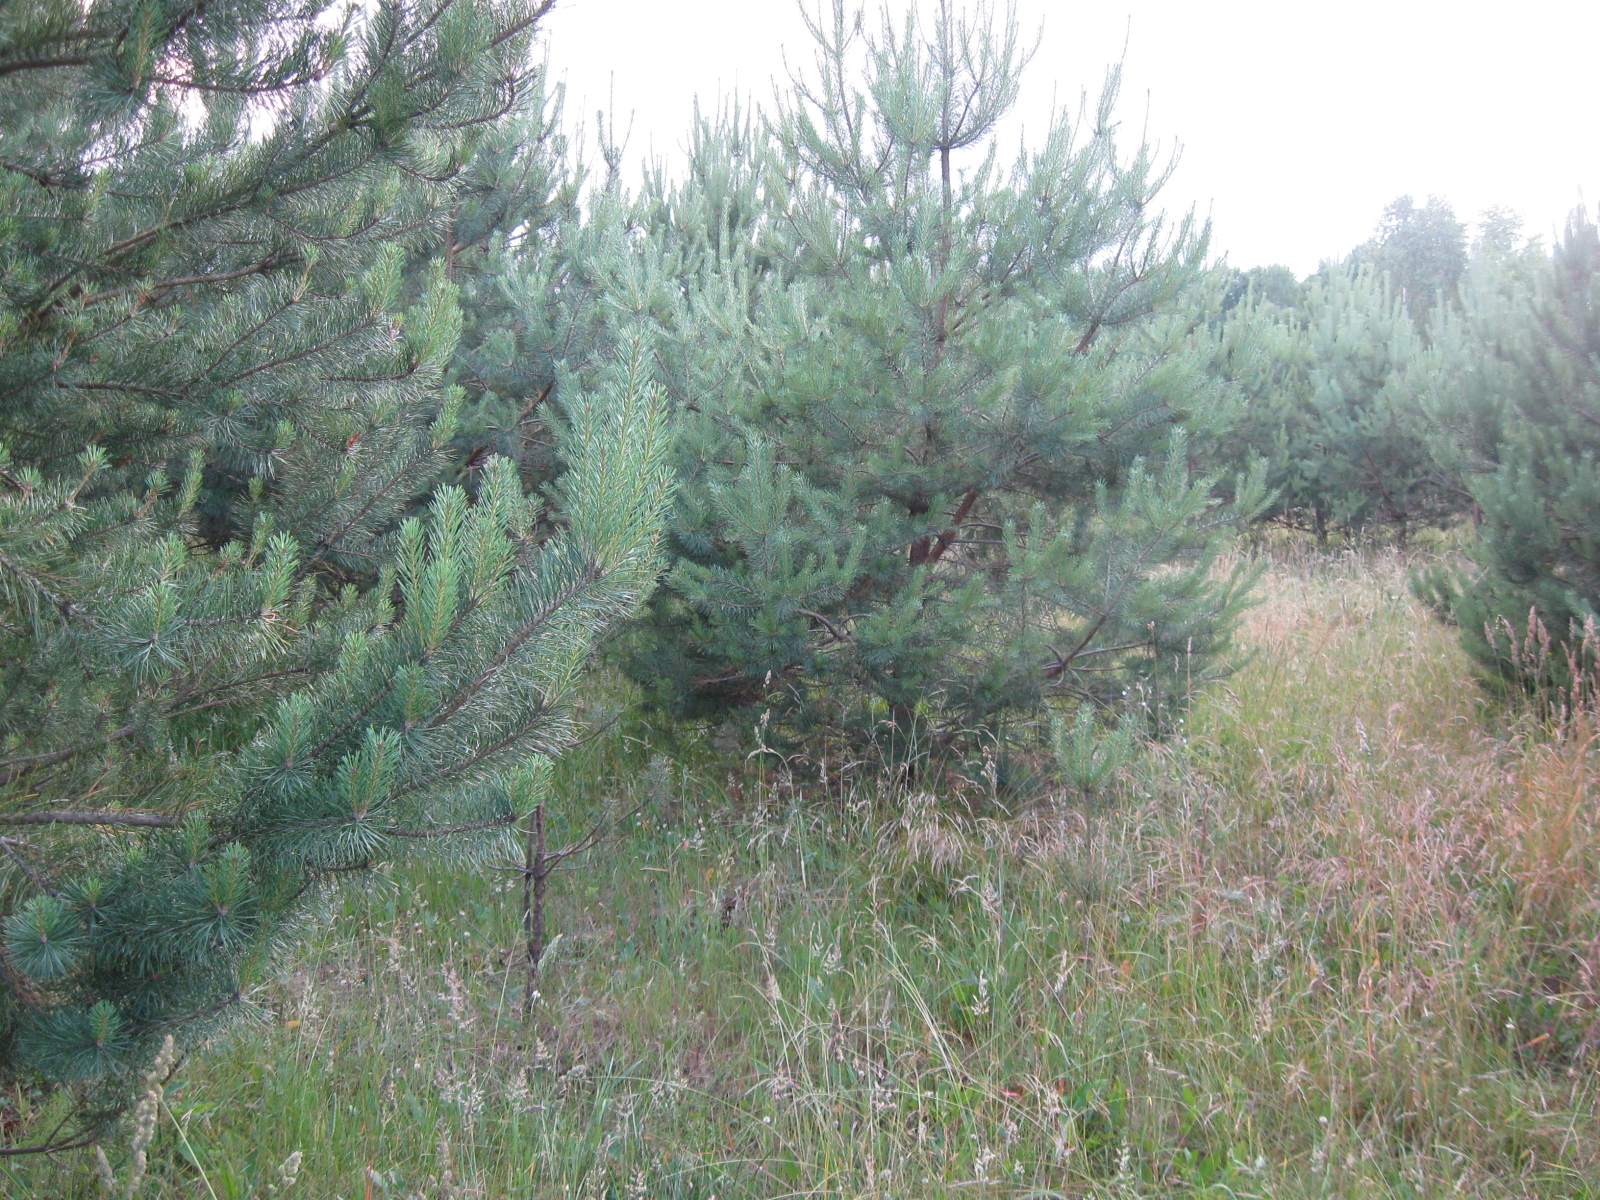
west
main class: Woodland
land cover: Pine dominated coniferous woodland
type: hemiboreal forest and nemoral coniferous forest and mixed broadleaved-coniferous forest
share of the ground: 50 - 75 %
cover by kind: coniferous forest trees 60 %, herbaceous plants 40 %
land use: Forestry
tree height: < 5 m
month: June
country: LT
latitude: 54.2021
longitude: 24.2163
